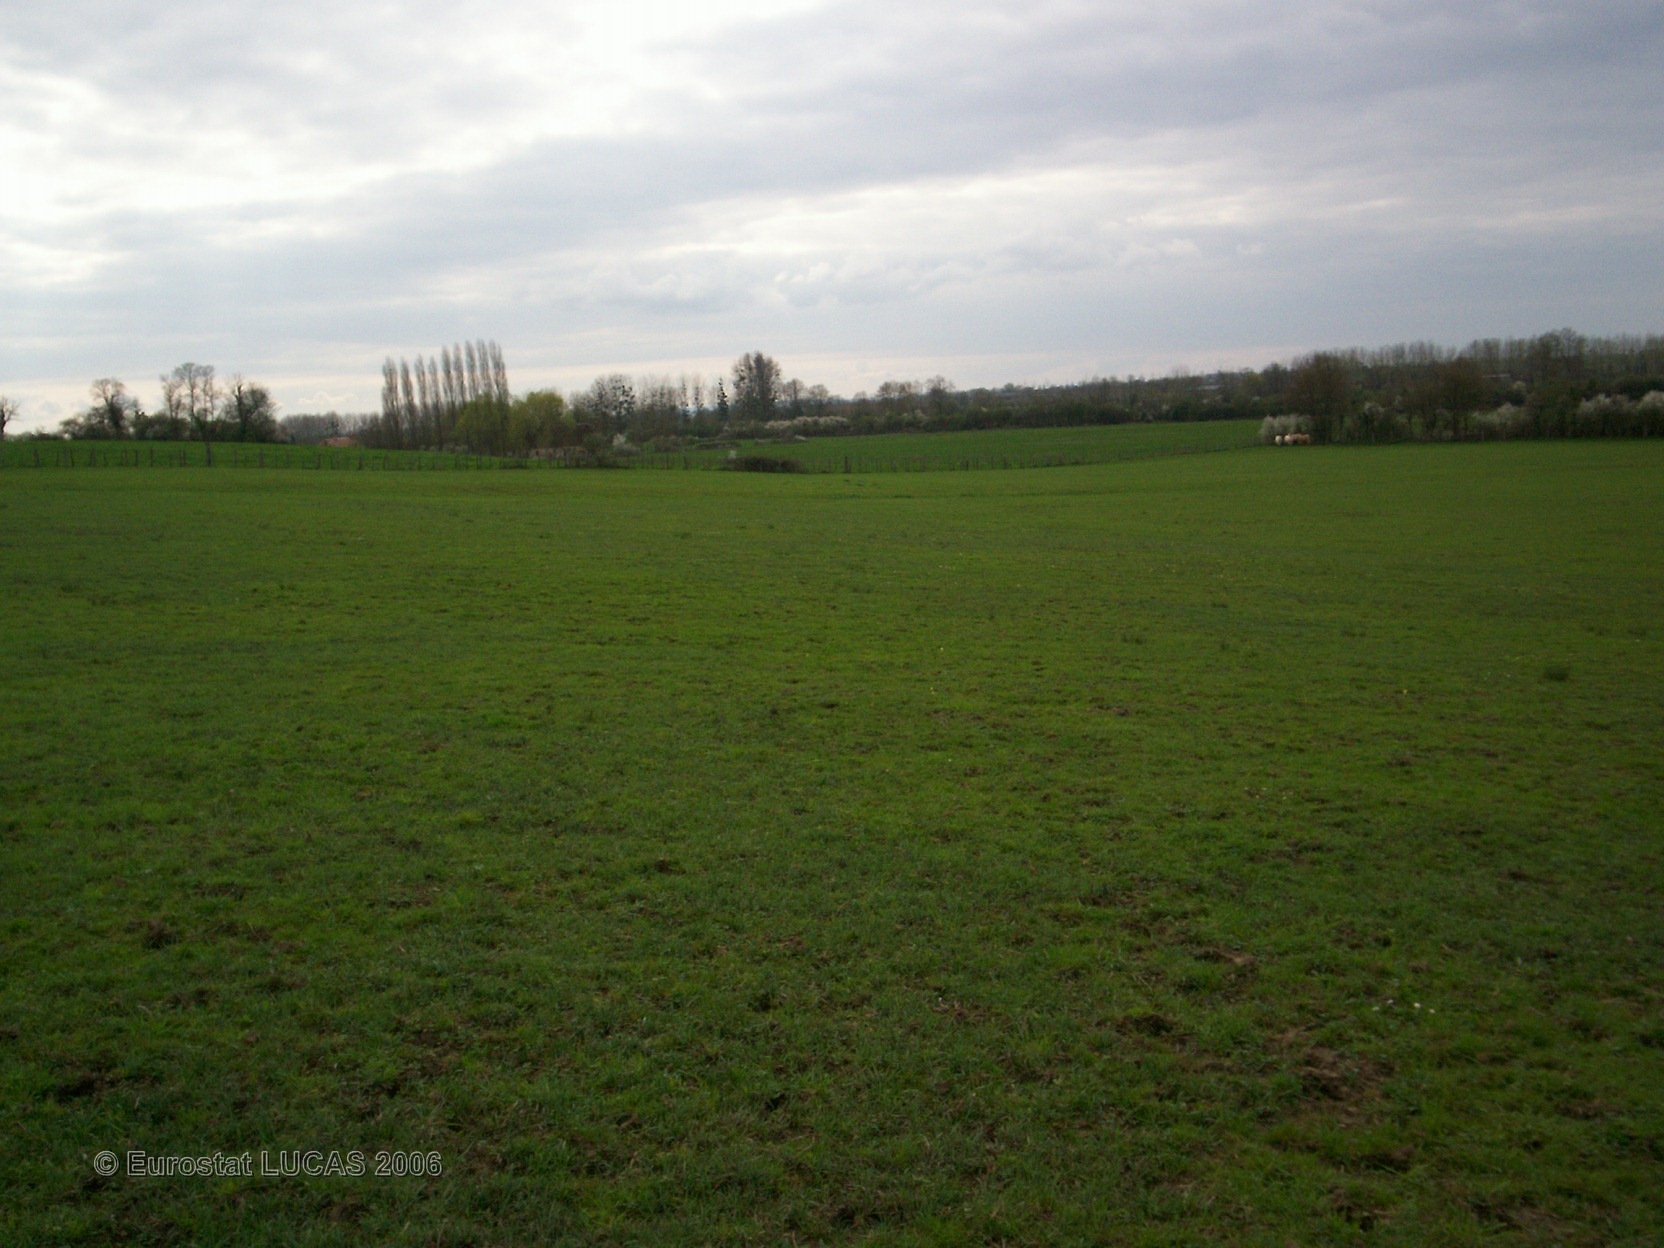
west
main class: Grassland
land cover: Grassland without tree/shrub cover
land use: Agriculture (excluding fallow land and kitchen gardens)
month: April
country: FR
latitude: 48.2340
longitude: 0.3482
